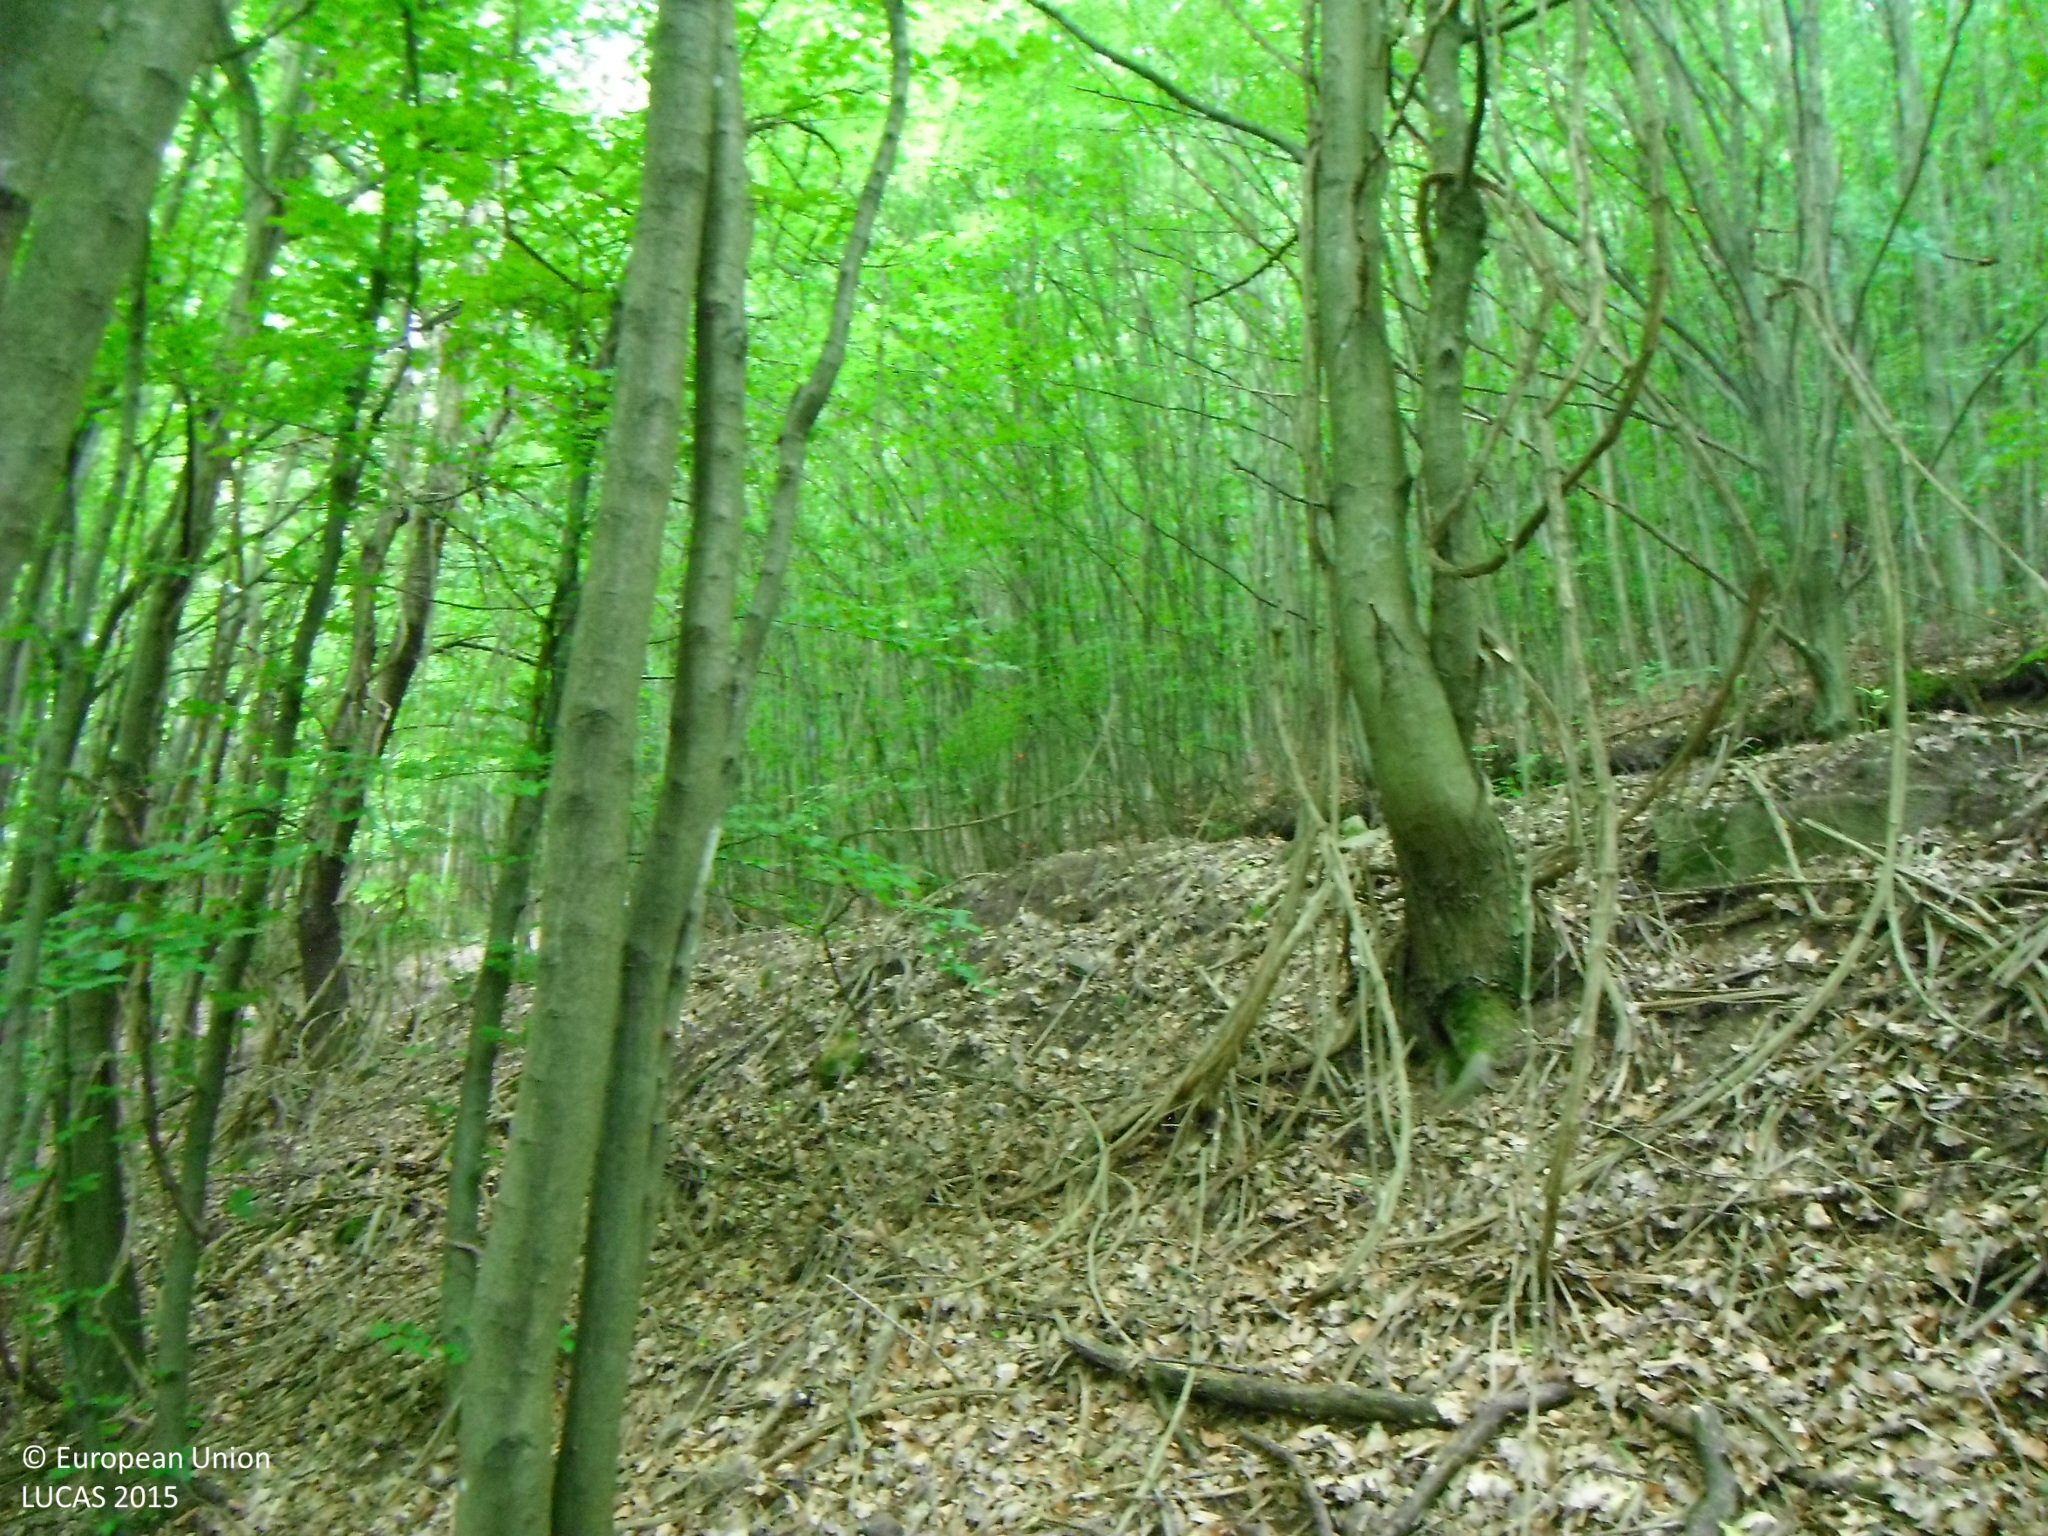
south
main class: Woodland
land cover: Broadleaved woodland
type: beech forest
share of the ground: > 75 %
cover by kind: broadleaved forest trees 100 %
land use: Forestry
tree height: > 5 m
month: June
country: SK
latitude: 48.2685
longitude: 19.2507
